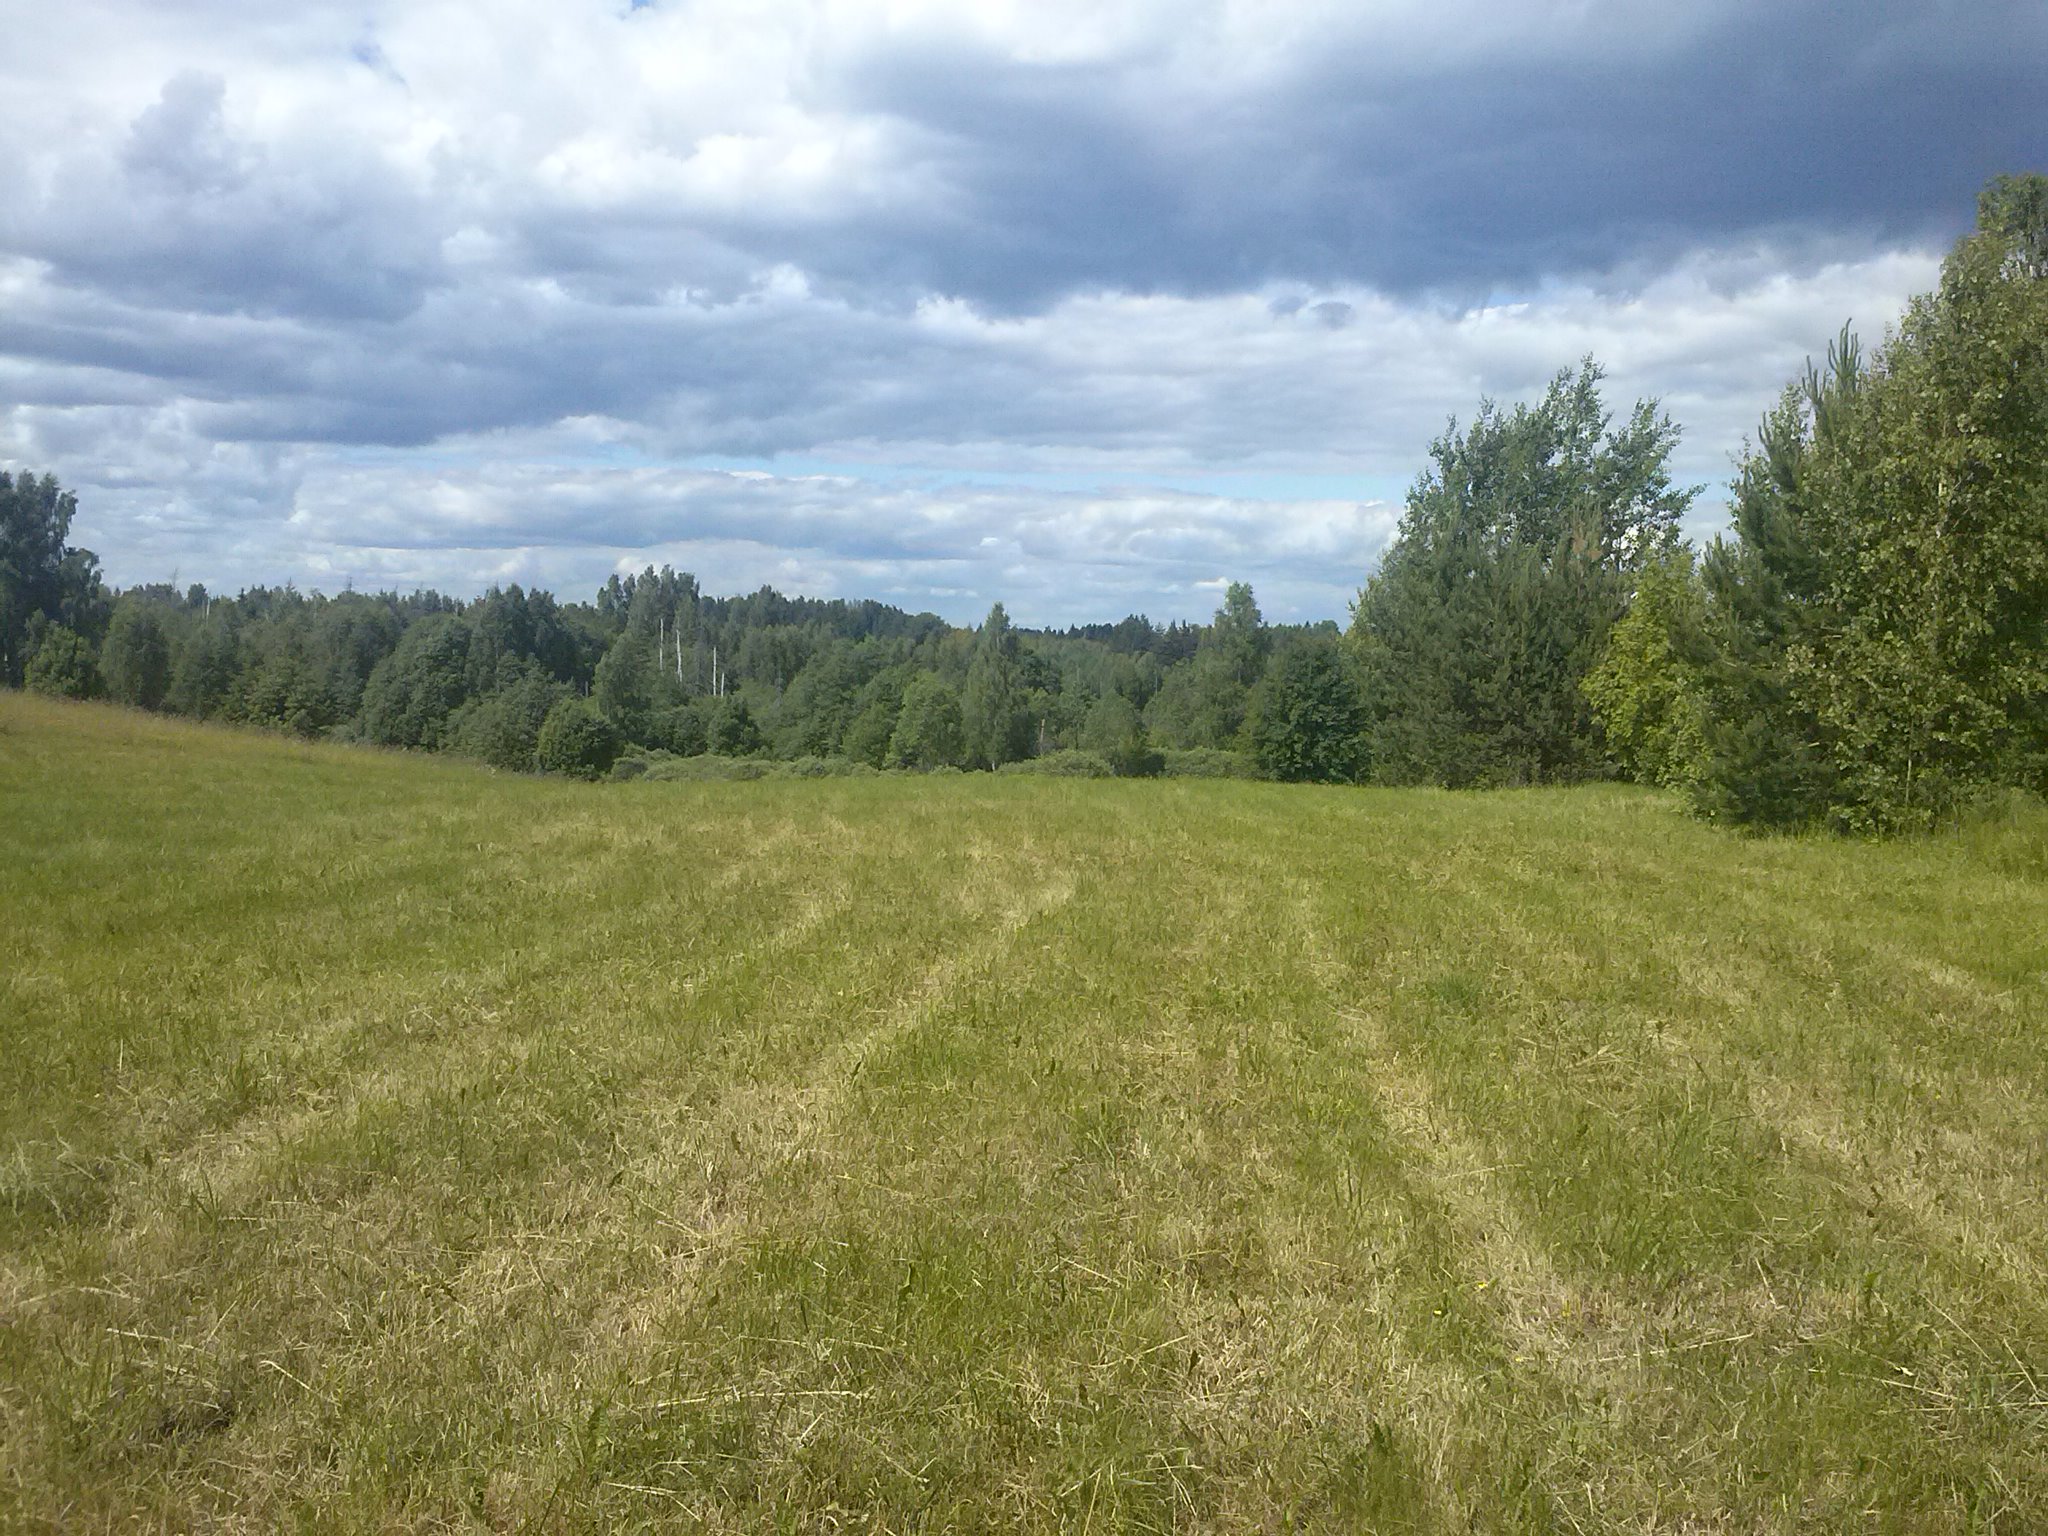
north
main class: Grassland
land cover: Grassland without tree/shrub cover
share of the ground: > 75 %
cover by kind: herbaceous plants 100 %
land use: Agriculture (excluding fallow land and kitchen gardens)
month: June
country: LV
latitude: 56.3877
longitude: 27.6623
